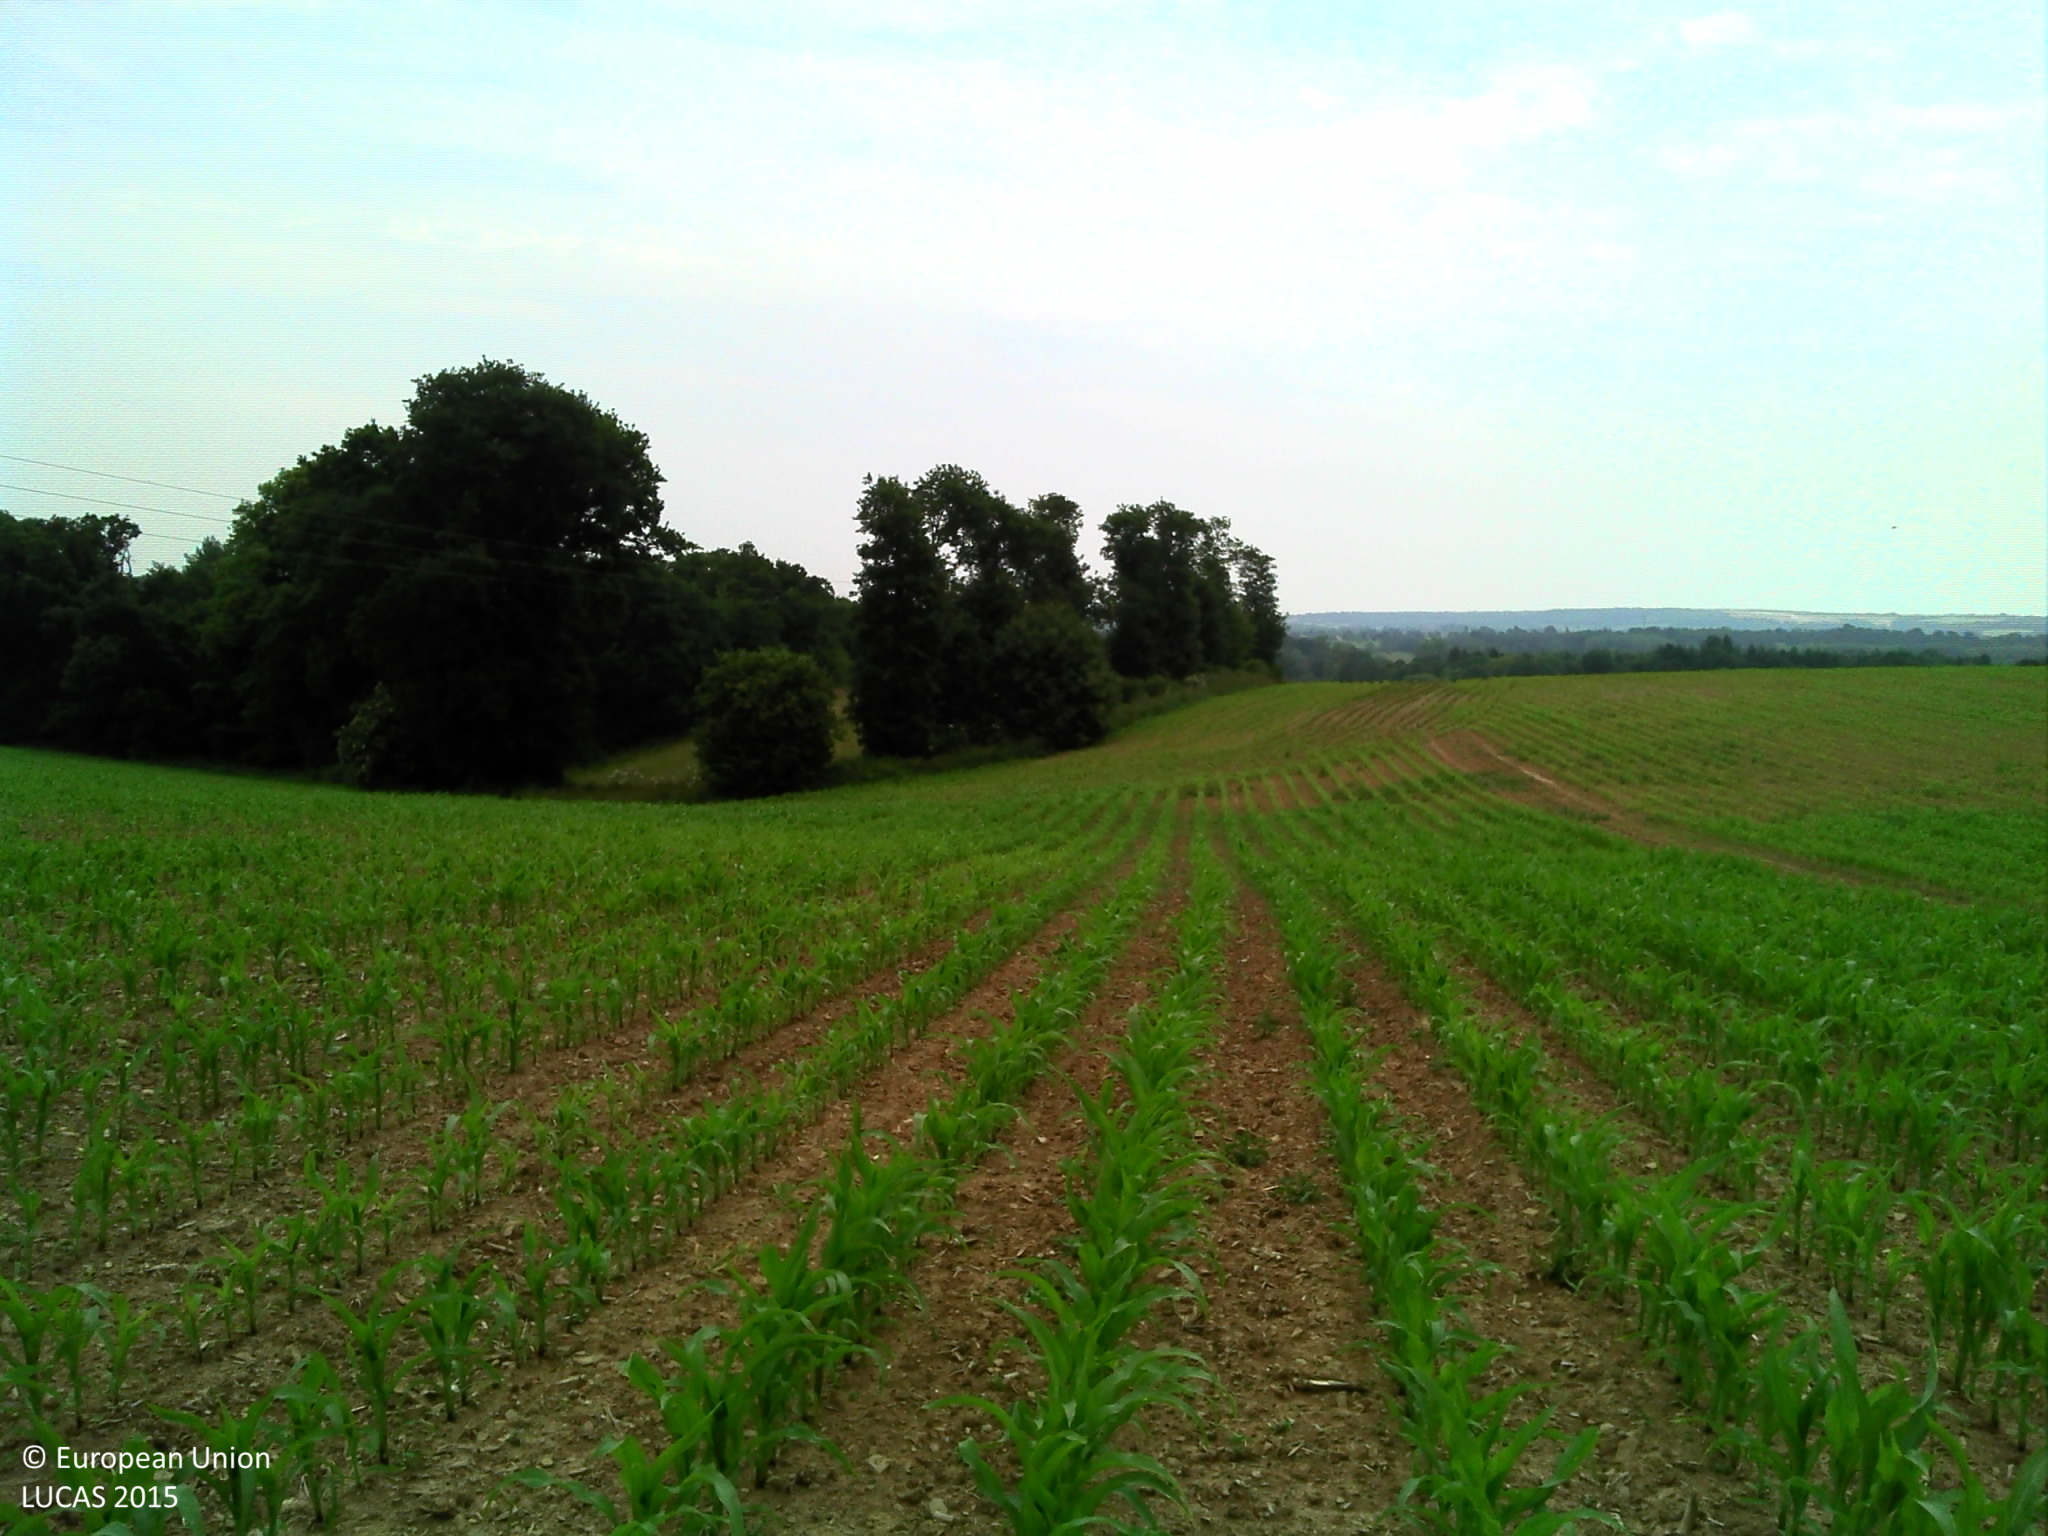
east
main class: Cropland
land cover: Maize
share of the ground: > 75 %
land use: Agriculture (excluding fallow land and kitchen gardens)
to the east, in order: Maize; Abandoned hedges; Maize; Abandoned hedges; Grassland without tree/shrub cover
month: June
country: FR
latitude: 48.1207
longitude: -2.0770
